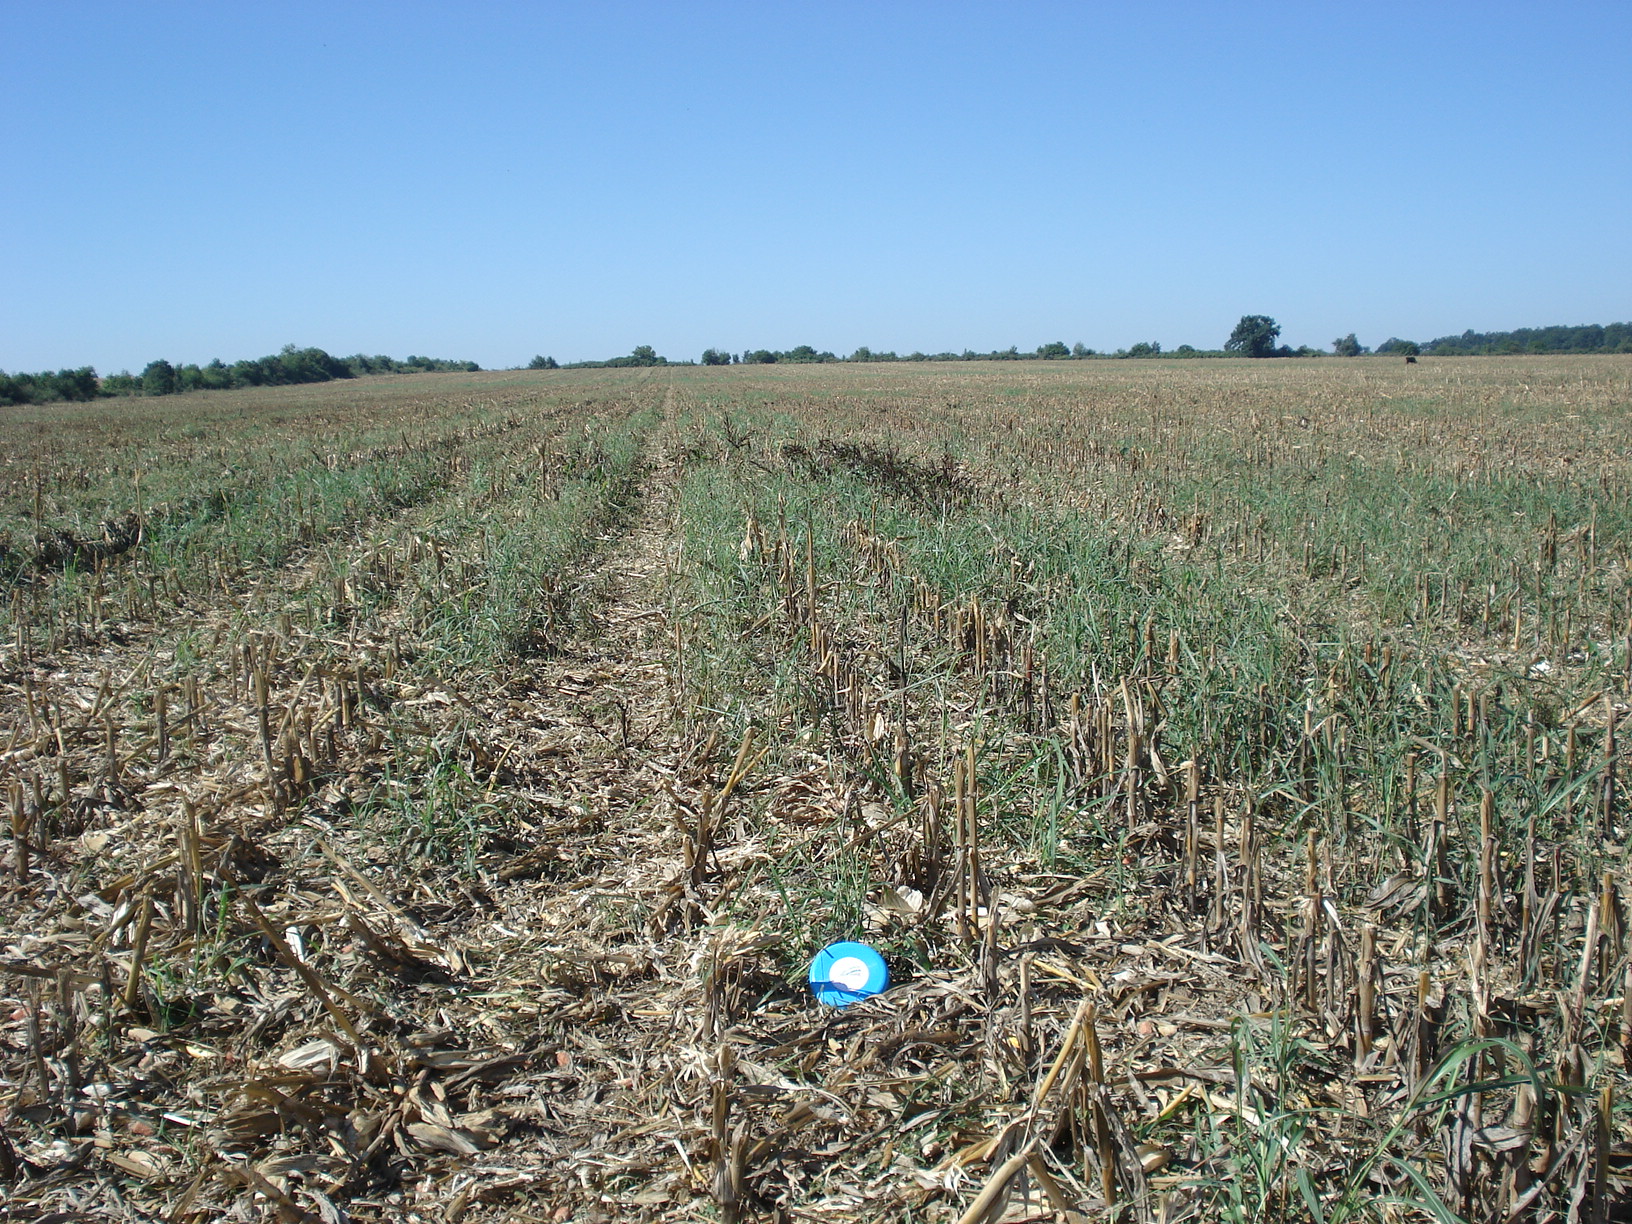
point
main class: Cropland
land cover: Maize
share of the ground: 50 - 75 %
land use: Agriculture (excluding fallow land and kitchen gardens)
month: September
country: BG
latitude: 43.2967
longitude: 25.1973
